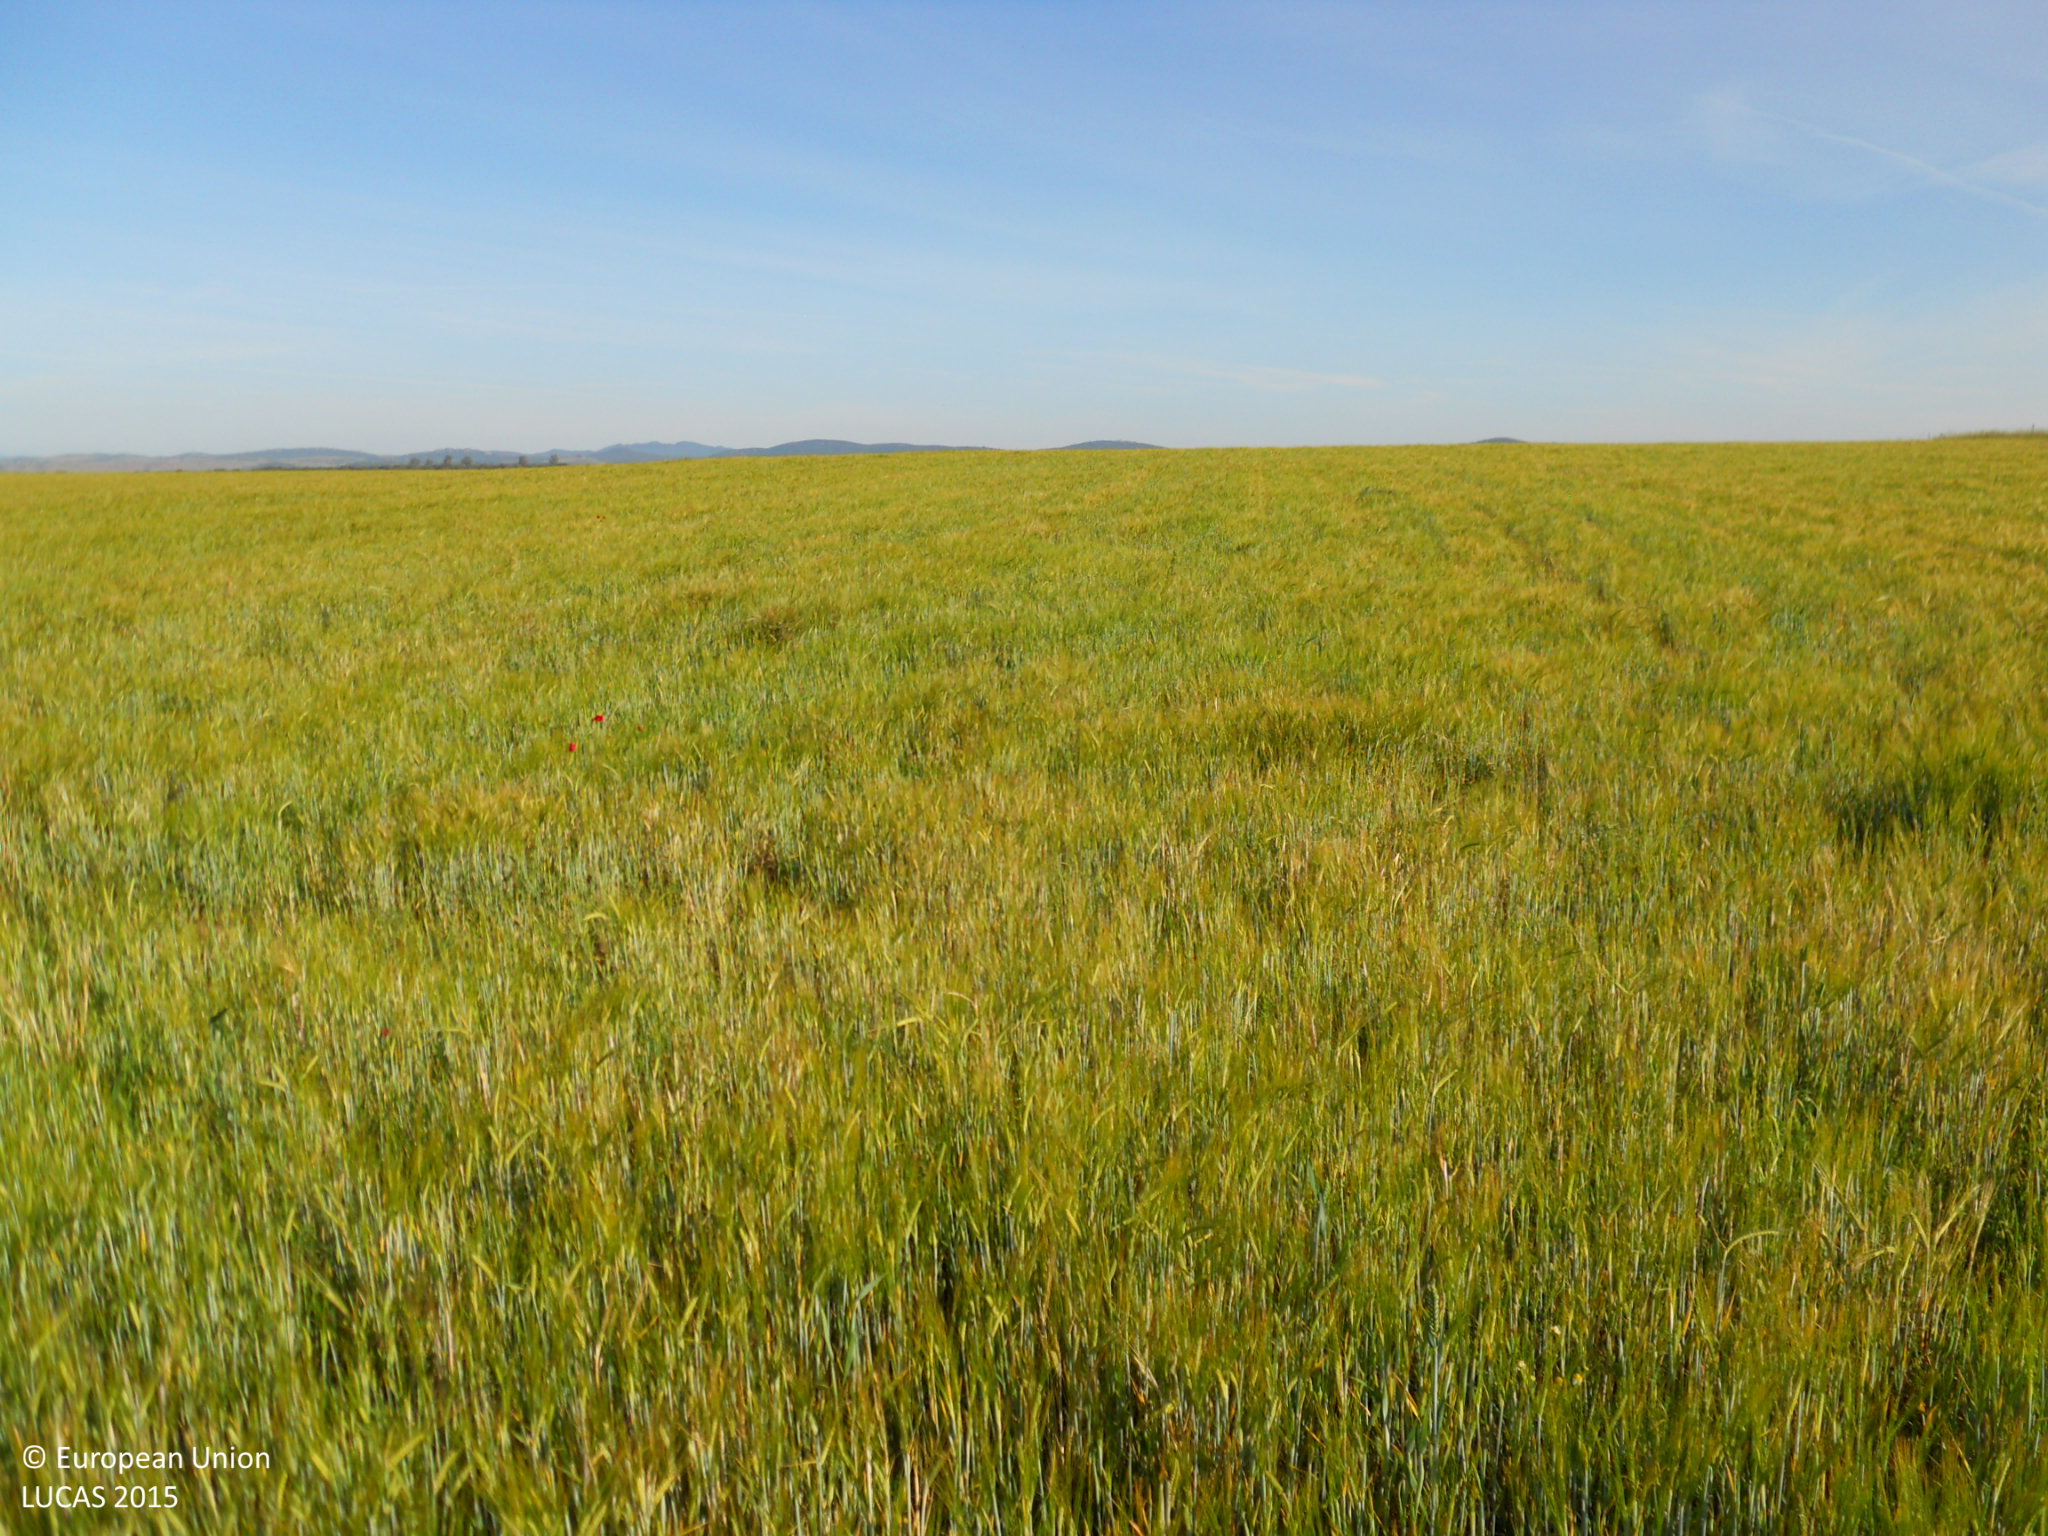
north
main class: Cropland
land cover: Barley
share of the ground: > 75 %
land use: Agriculture (excluding fallow land and kitchen gardens)
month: April
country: ES
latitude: 39.0759
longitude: -6.8429
